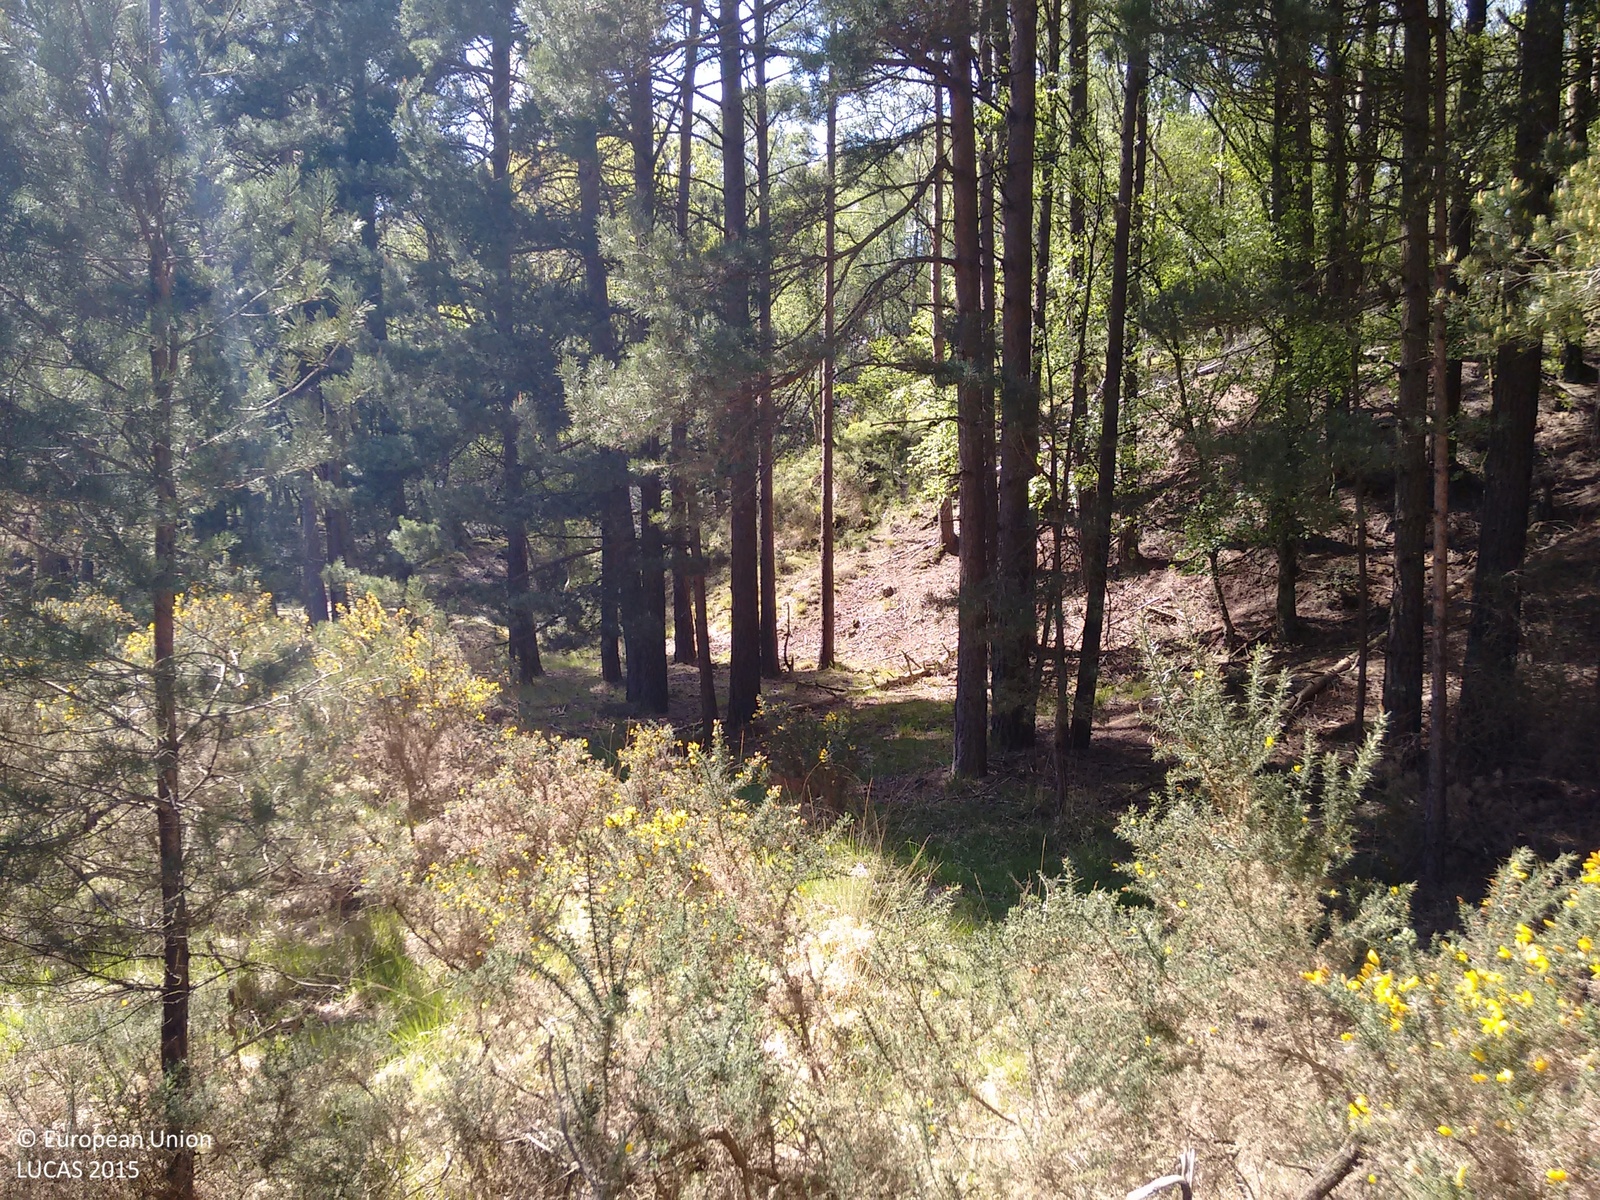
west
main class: Woodland
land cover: Pine dominated mixed woodland
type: hemiboreal forest and nemoral coniferous forest and mixed broadleaved-coniferous forest
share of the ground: > 75 %
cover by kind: coniferous forest trees 70 %, broadleaved forest trees 25 %, shrubs 5 %
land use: Forestry
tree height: > 5 m
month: May
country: GB
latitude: 50.6469
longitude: -2.0947
